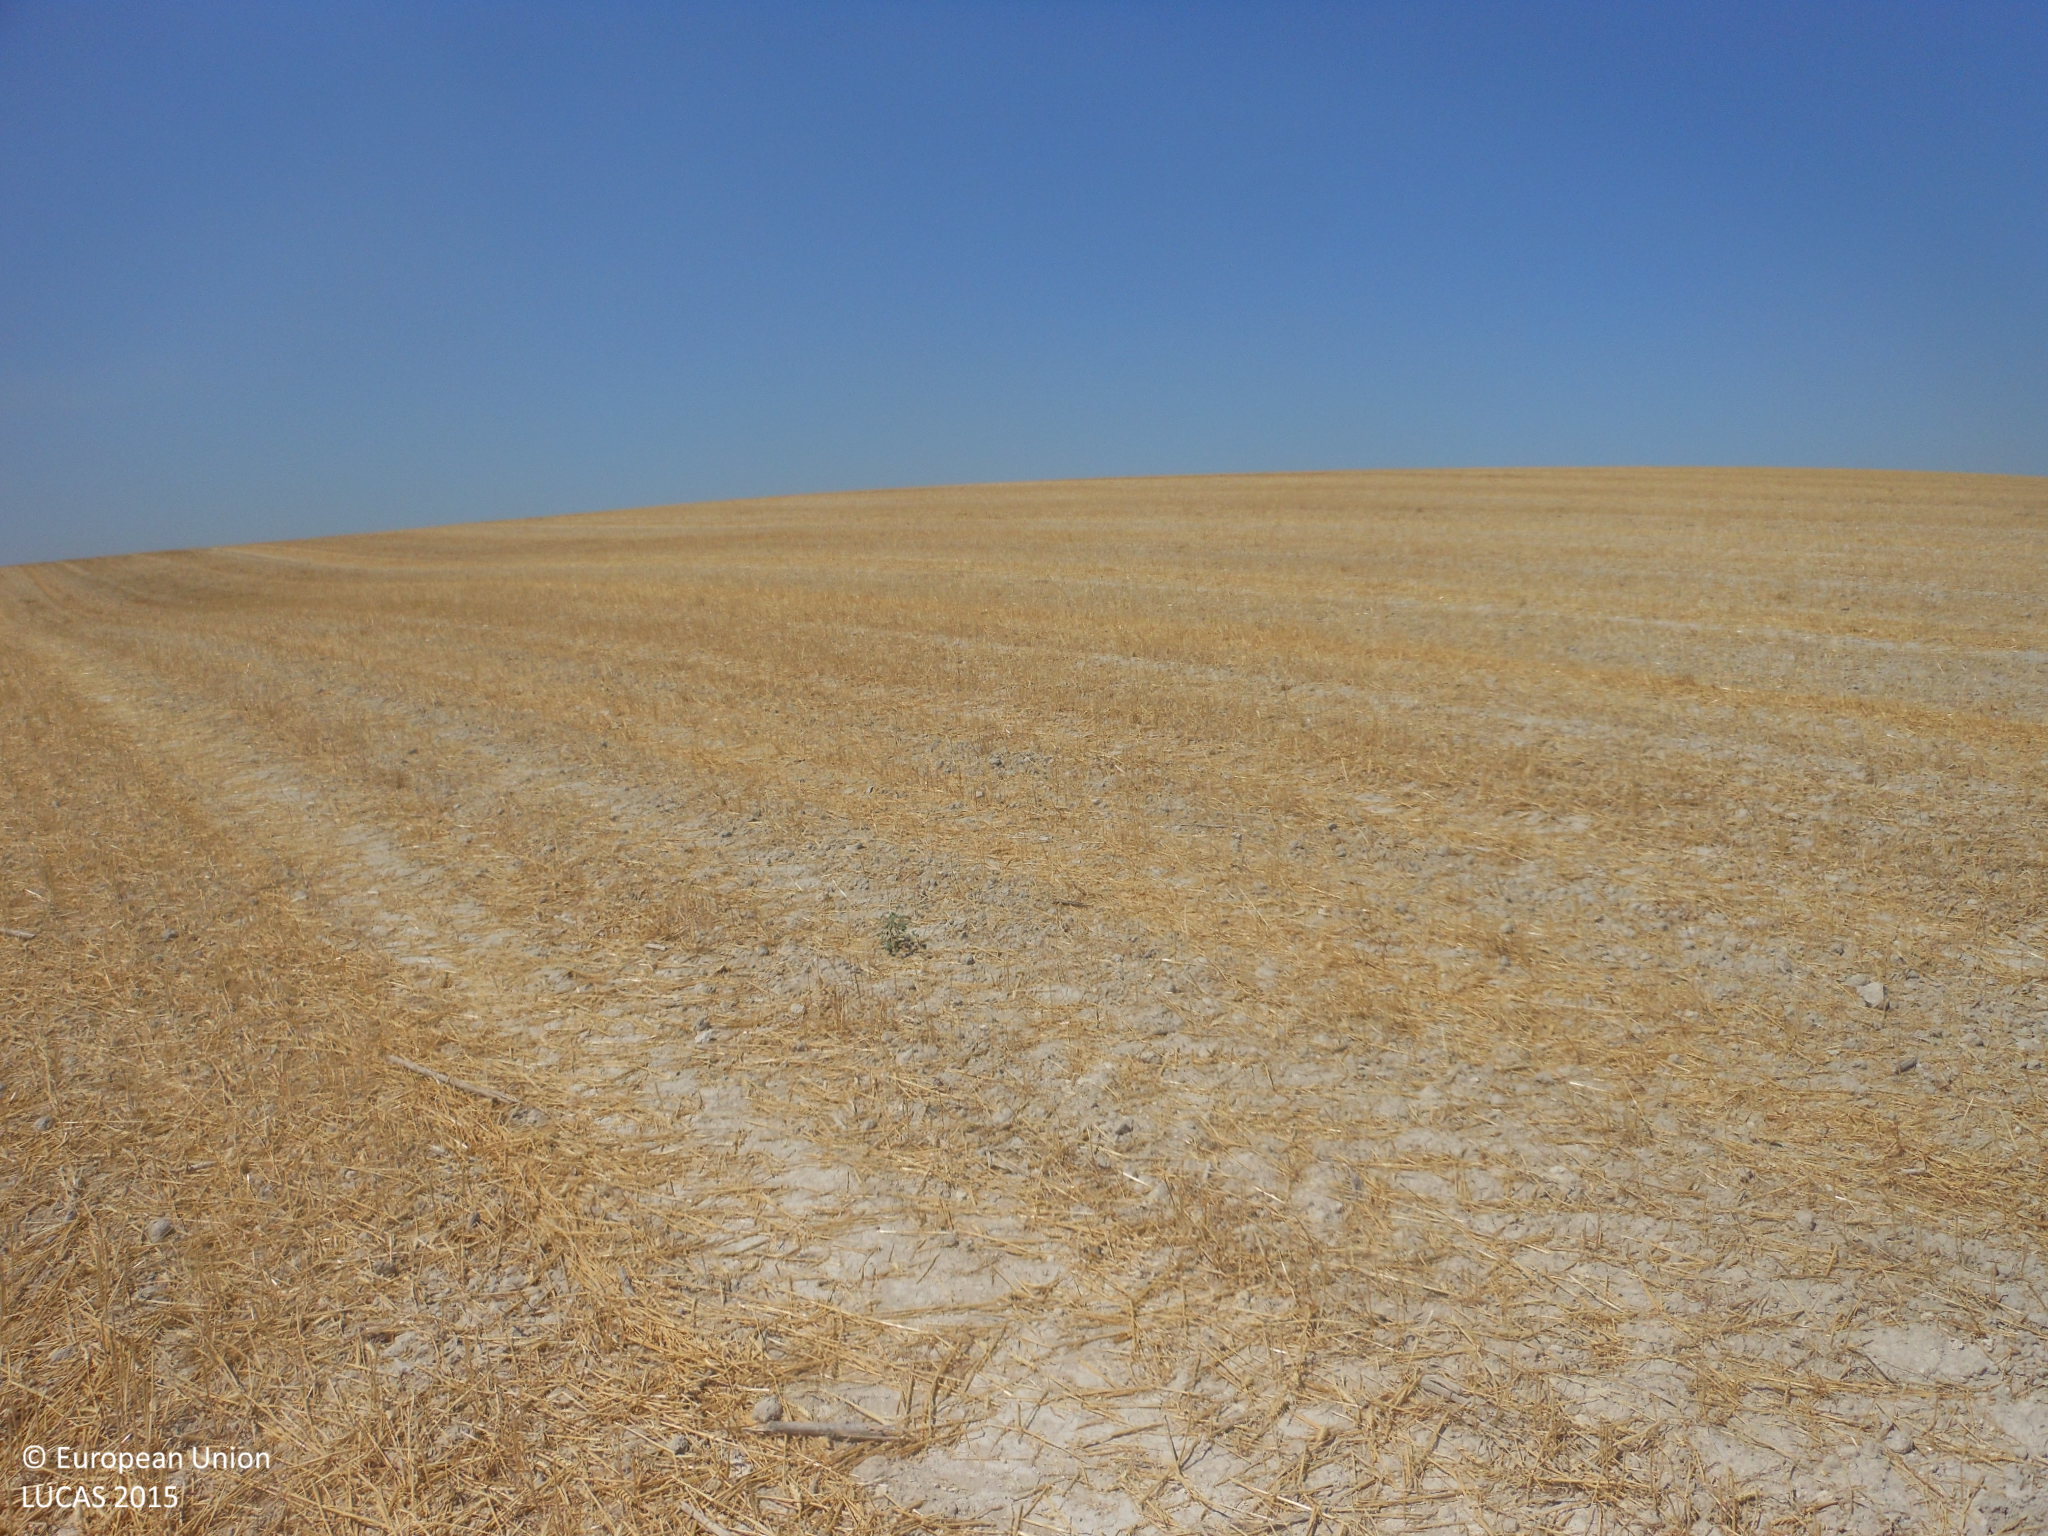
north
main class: Cropland
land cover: Common wheat
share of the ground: < 10 %
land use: Agriculture (excluding fallow land and kitchen gardens)
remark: Harvested field
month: July
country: ES
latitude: 37.3008
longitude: -5.3667
